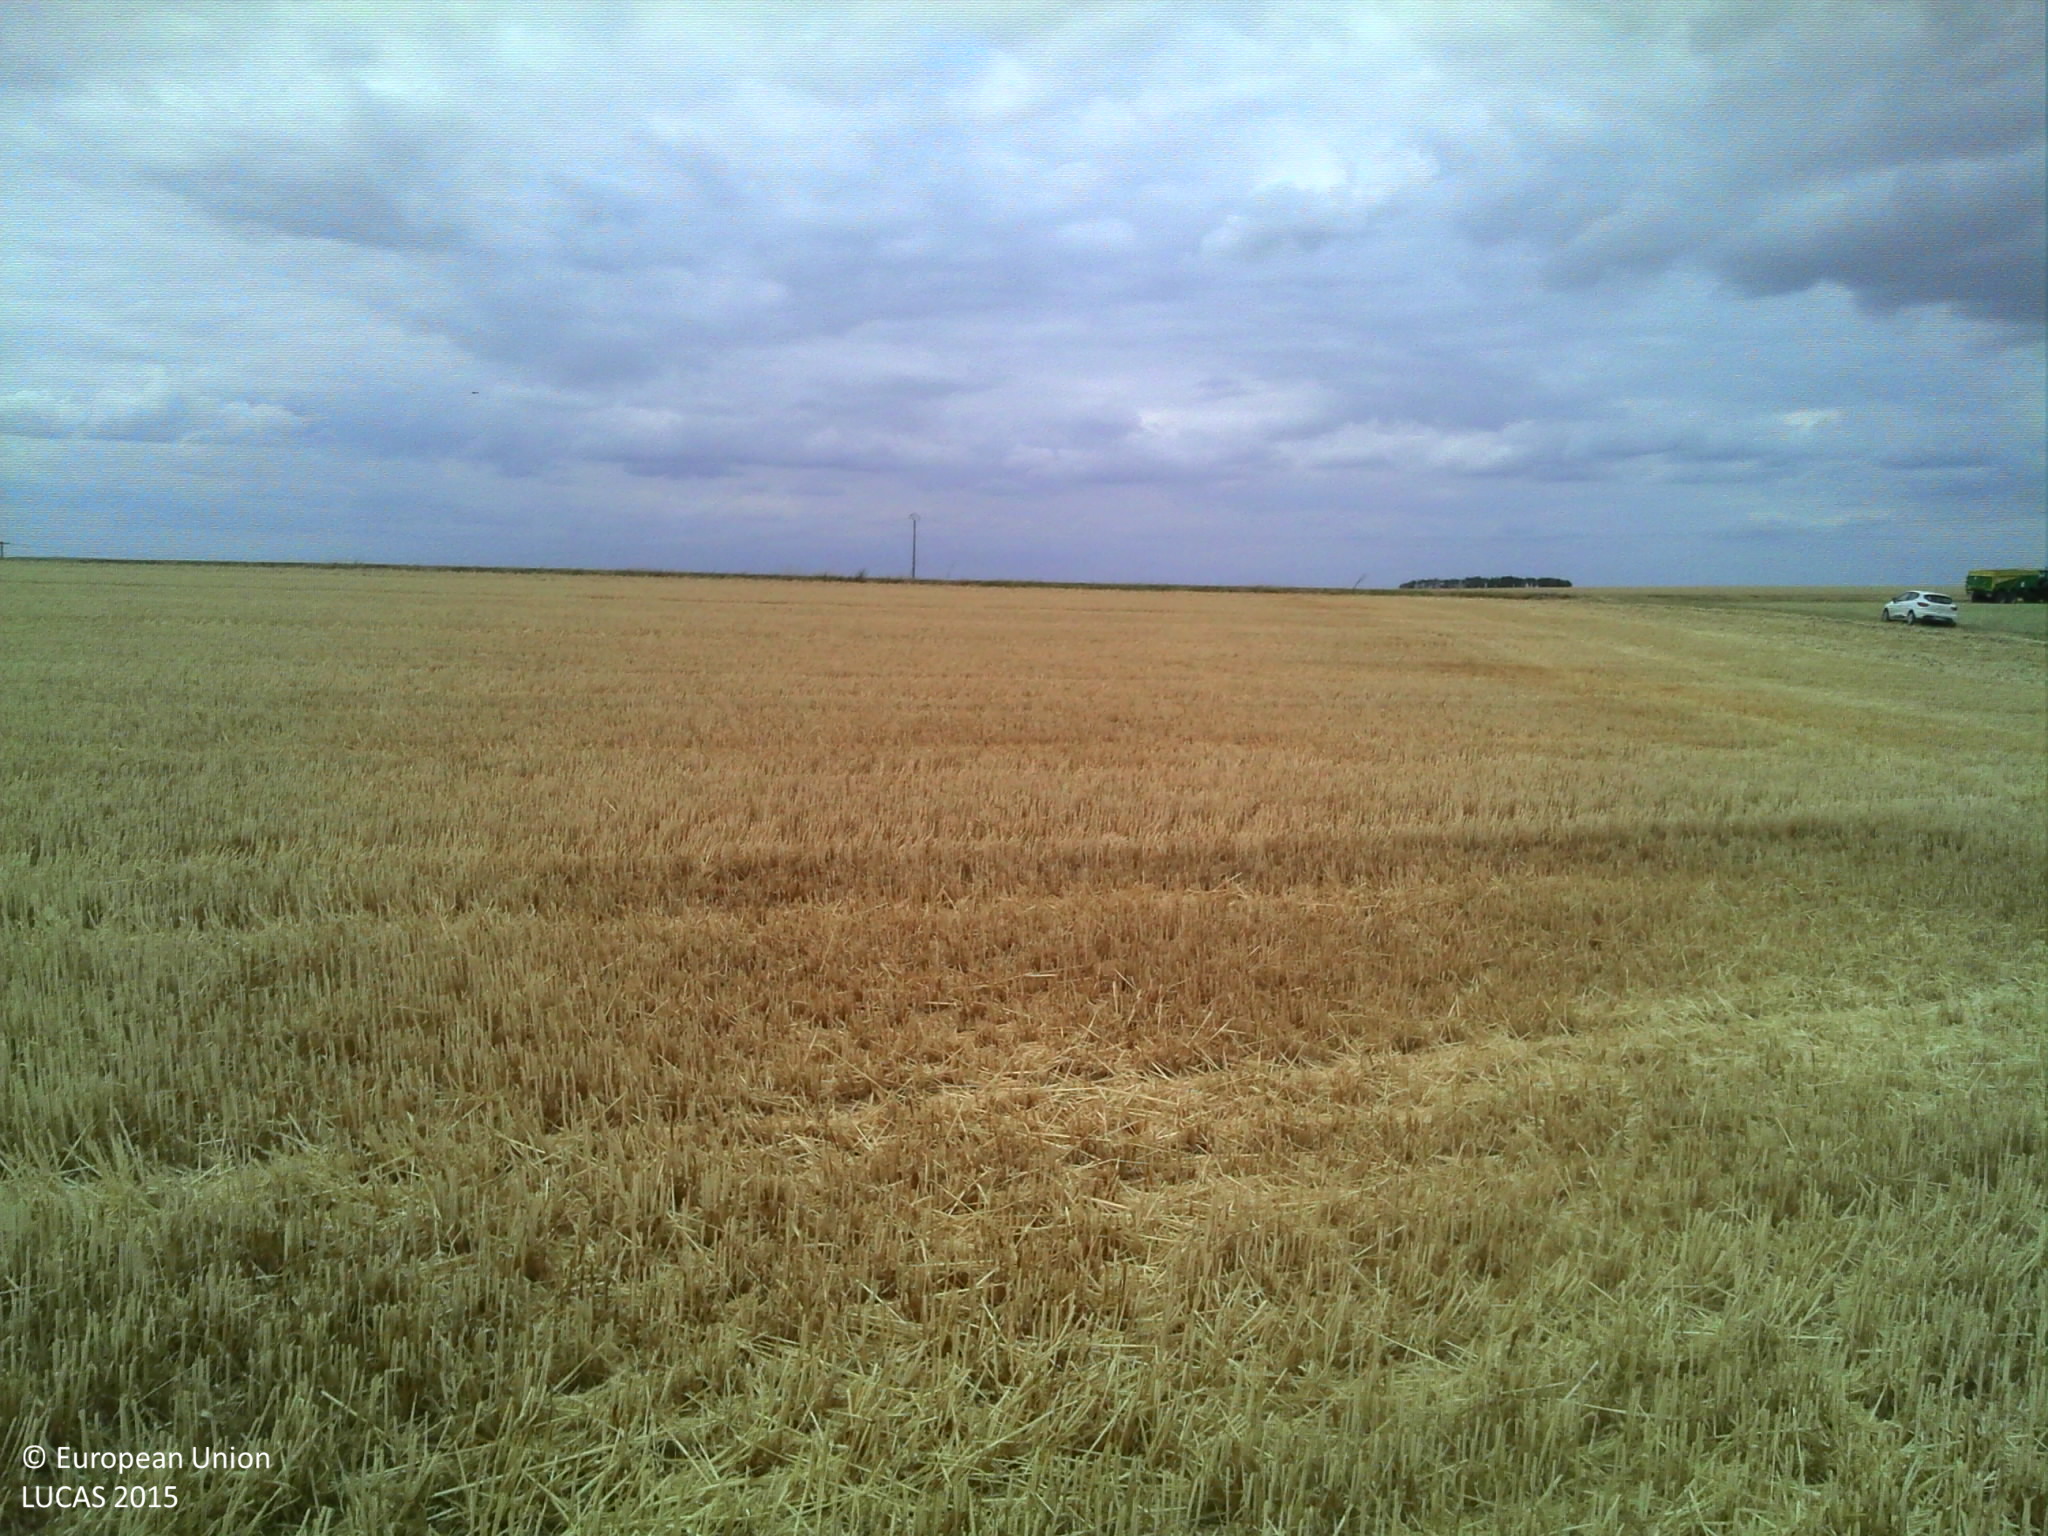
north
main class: Cropland
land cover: Common wheat
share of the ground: > 75 %
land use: Agriculture (excluding fallow land and kitchen gardens)
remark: Harvested field
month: July
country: FR
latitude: 48.3667
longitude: 3.3660
